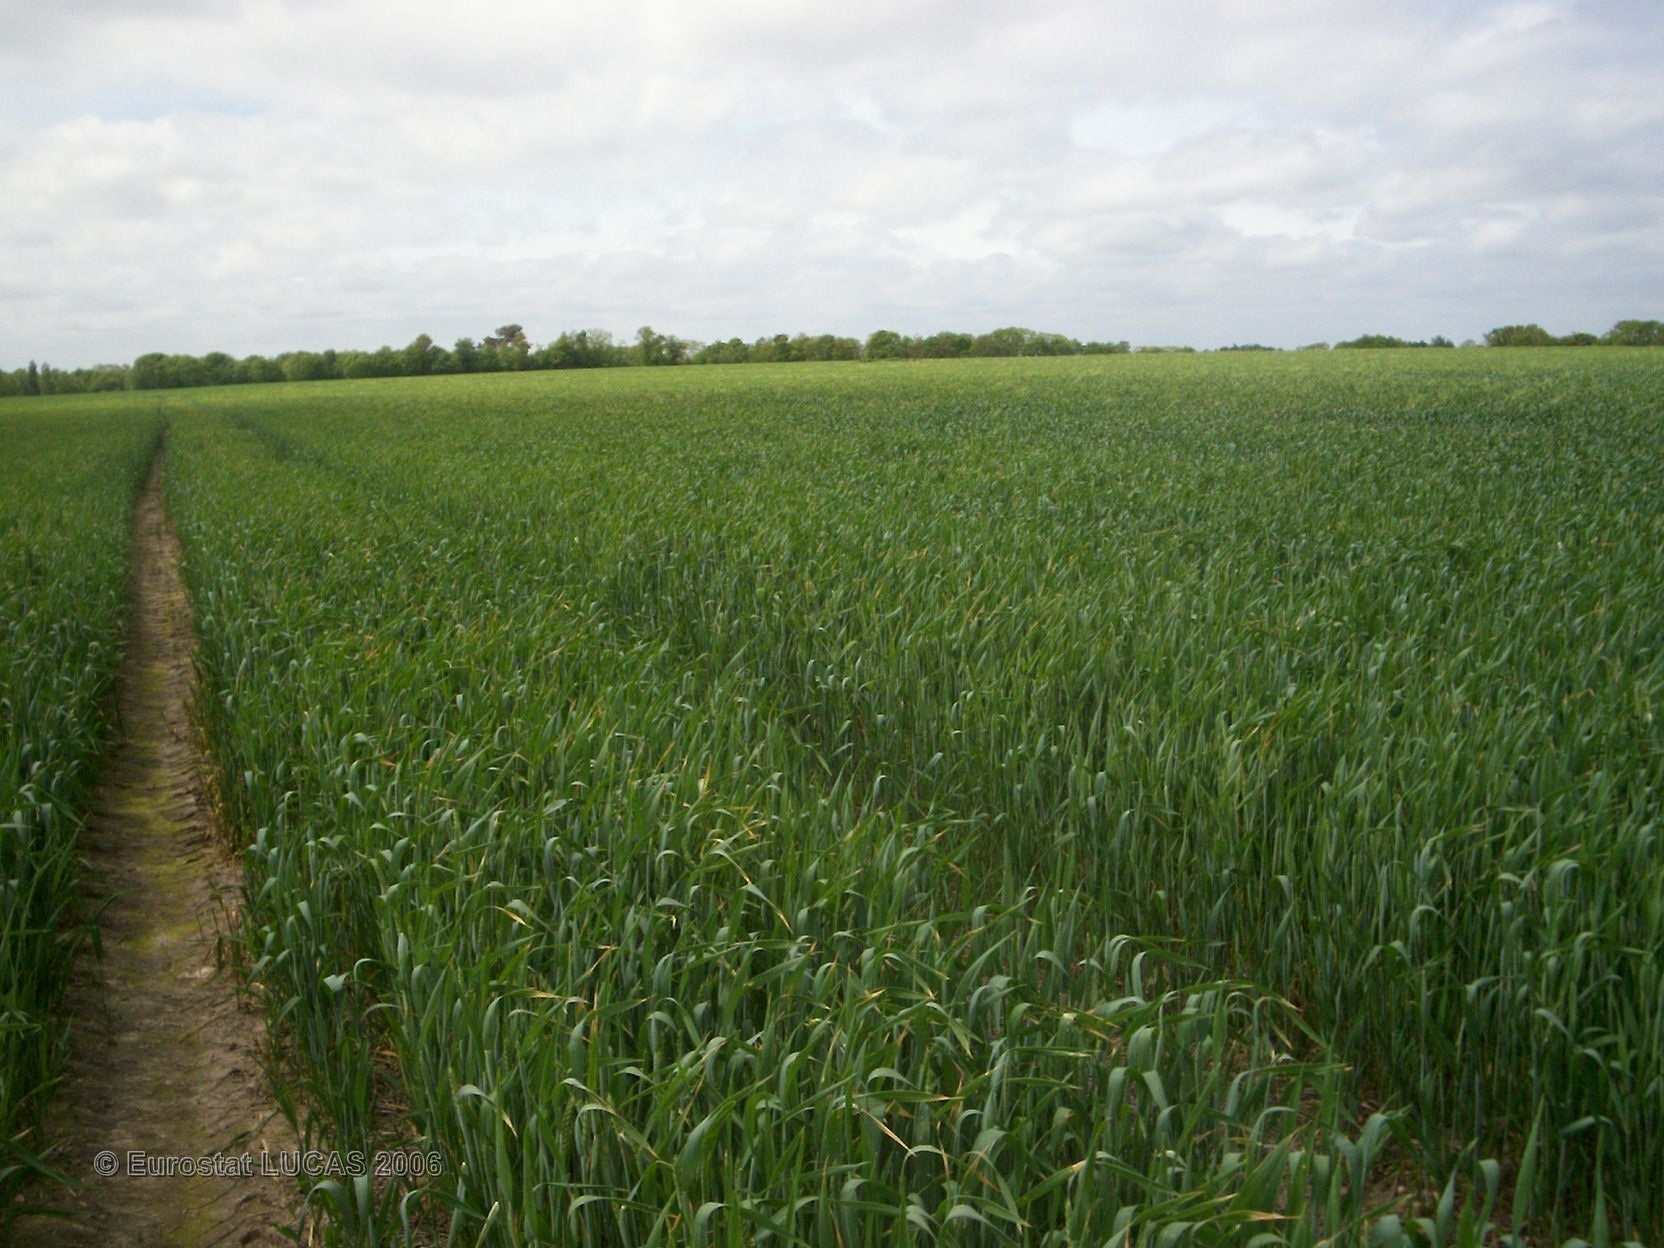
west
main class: Cropland
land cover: Common wheat
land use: Agriculture (excluding fallow land and kitchen gardens)
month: May
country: FR
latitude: 47.6373
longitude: -1.5033
